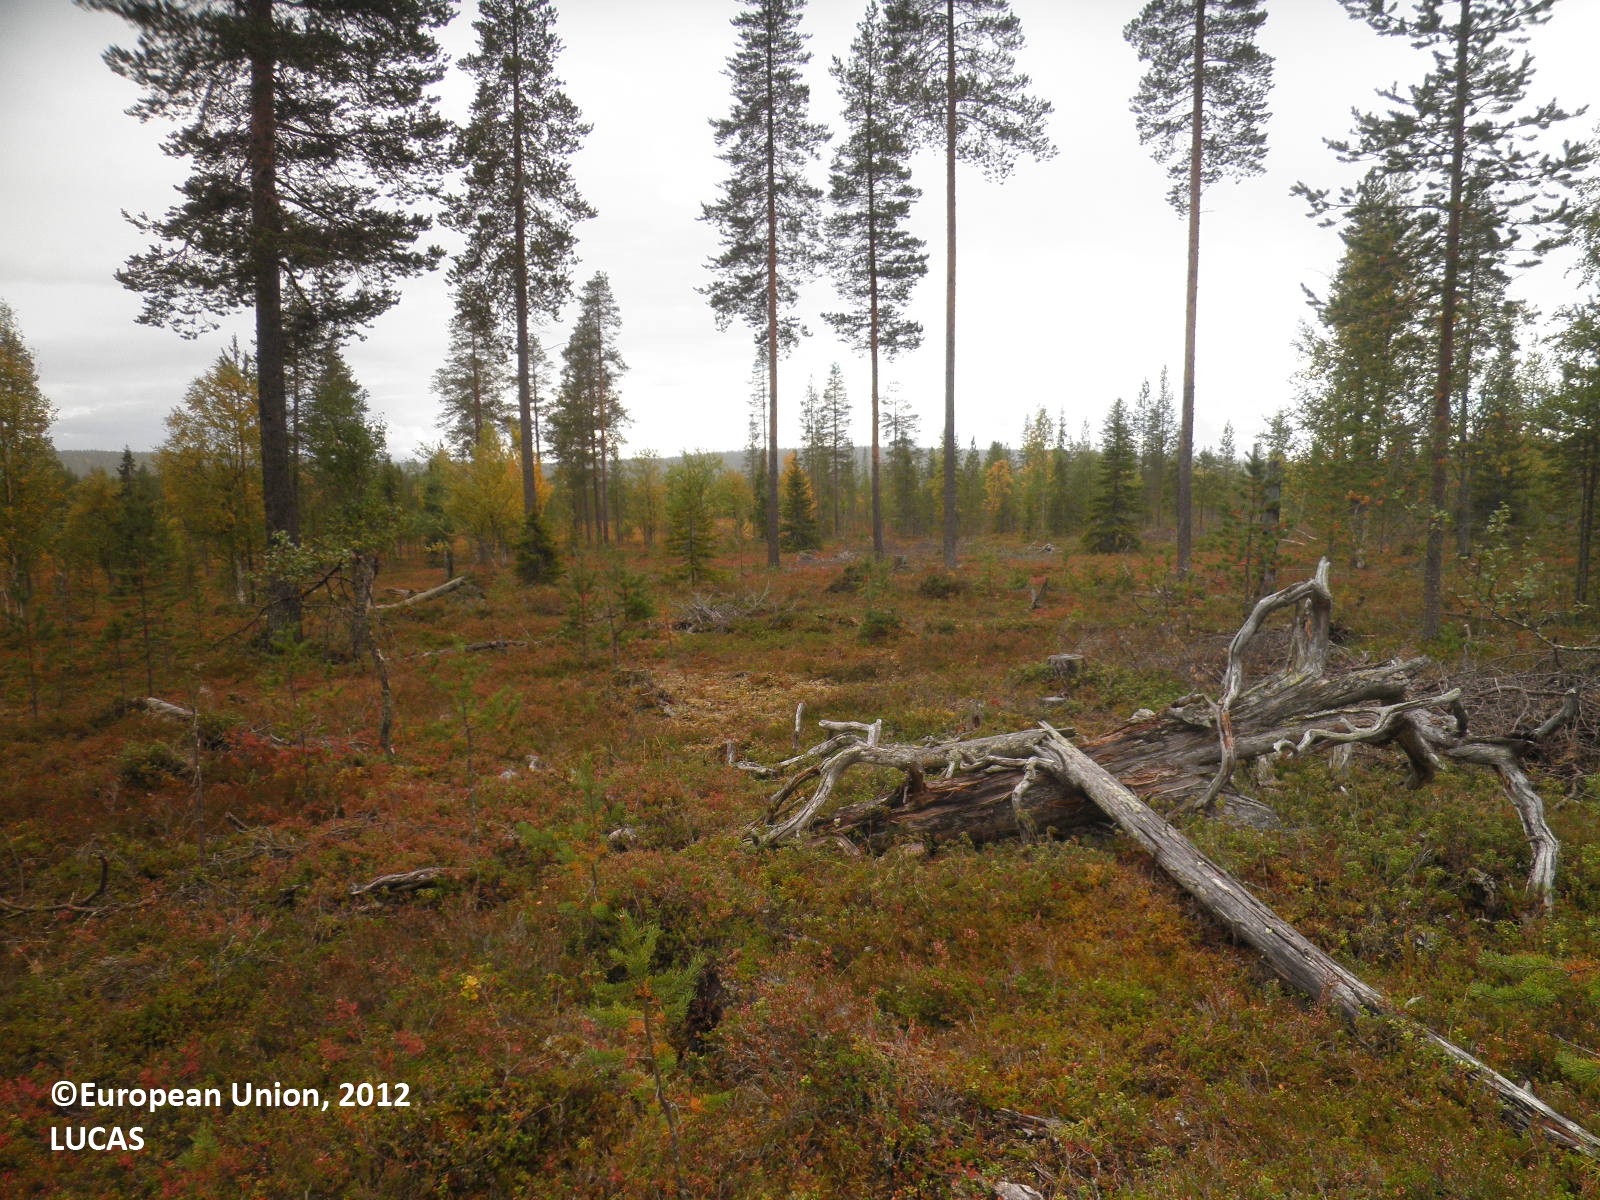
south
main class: Shrubland
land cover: Shrubland with sparse tree cover
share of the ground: > 75 %
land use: Forestry
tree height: > 5 m
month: September
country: FI
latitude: 67.4180
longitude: 28.4469
